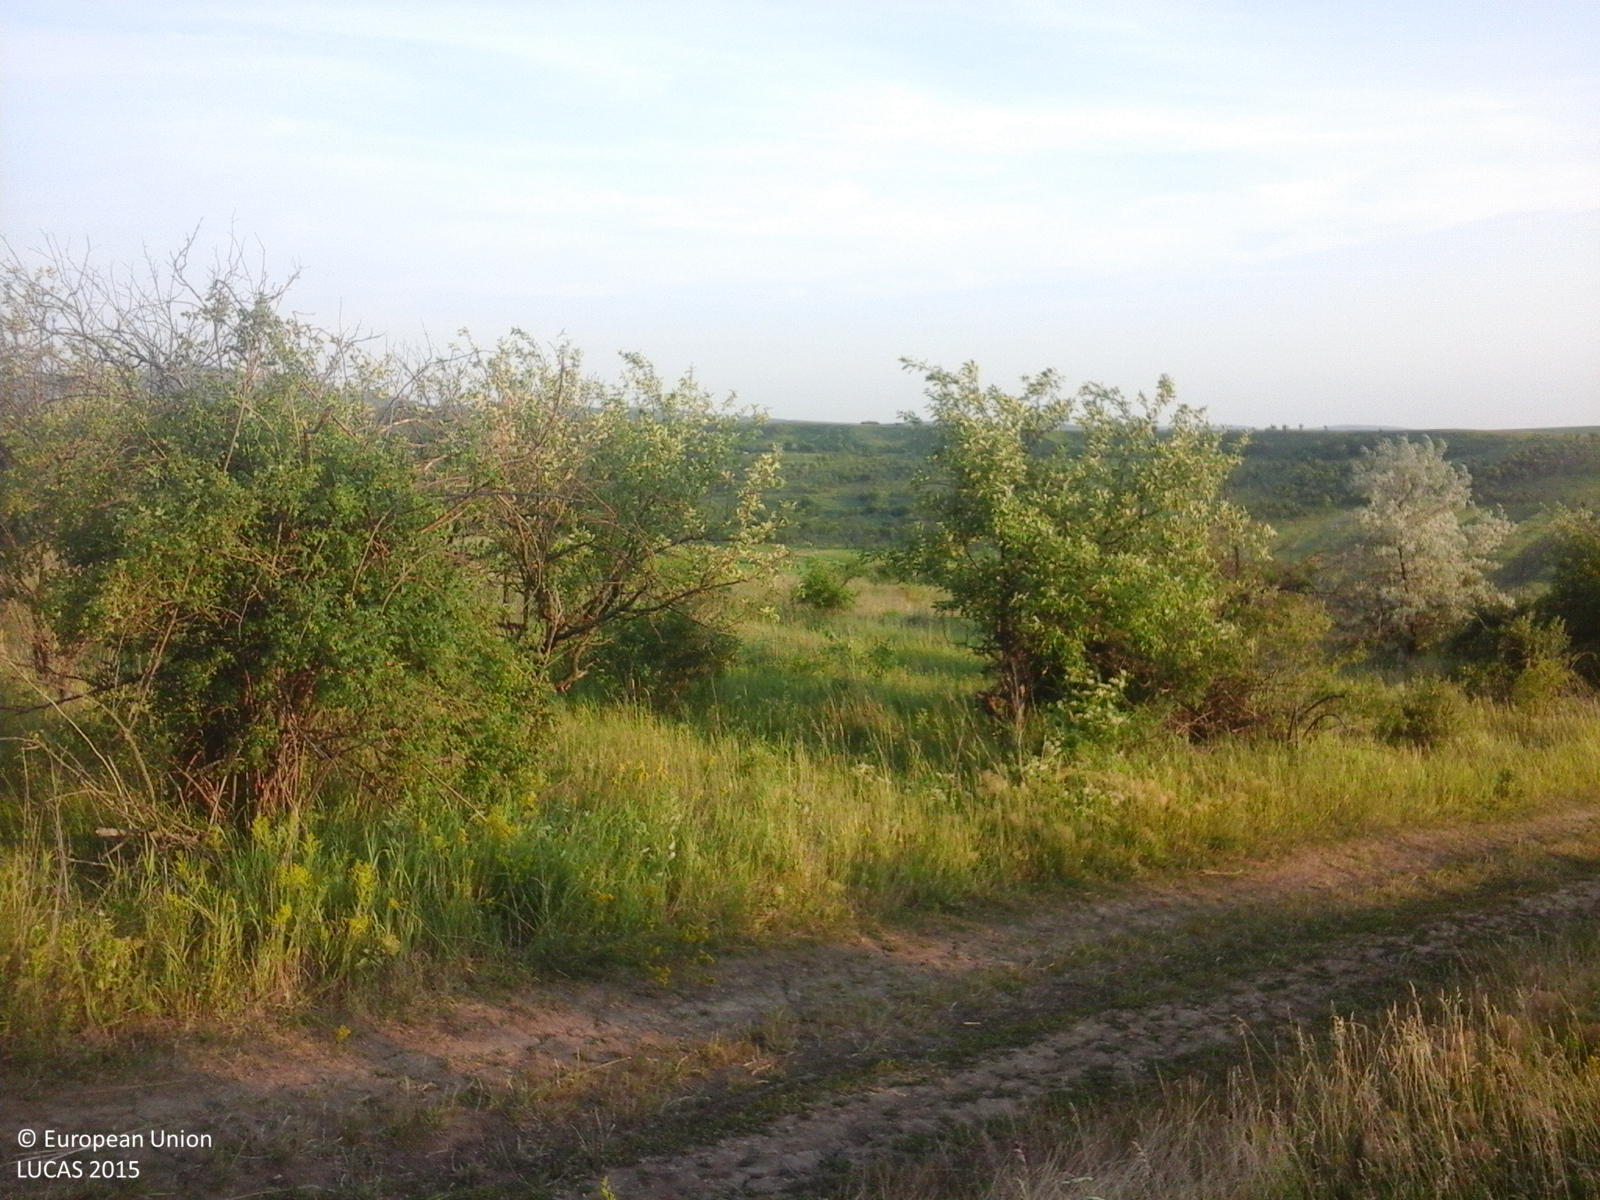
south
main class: Grassland
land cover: Grassland with sparse tree/shrub cover
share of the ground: > 75 %
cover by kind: herbaceous plants 85 %, shrubs 10 %, broadleaved forest trees 5 %
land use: Agriculture (excluding fallow land and kitchen gardens)
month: June
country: RO
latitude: 46.8636
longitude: 27.2781
